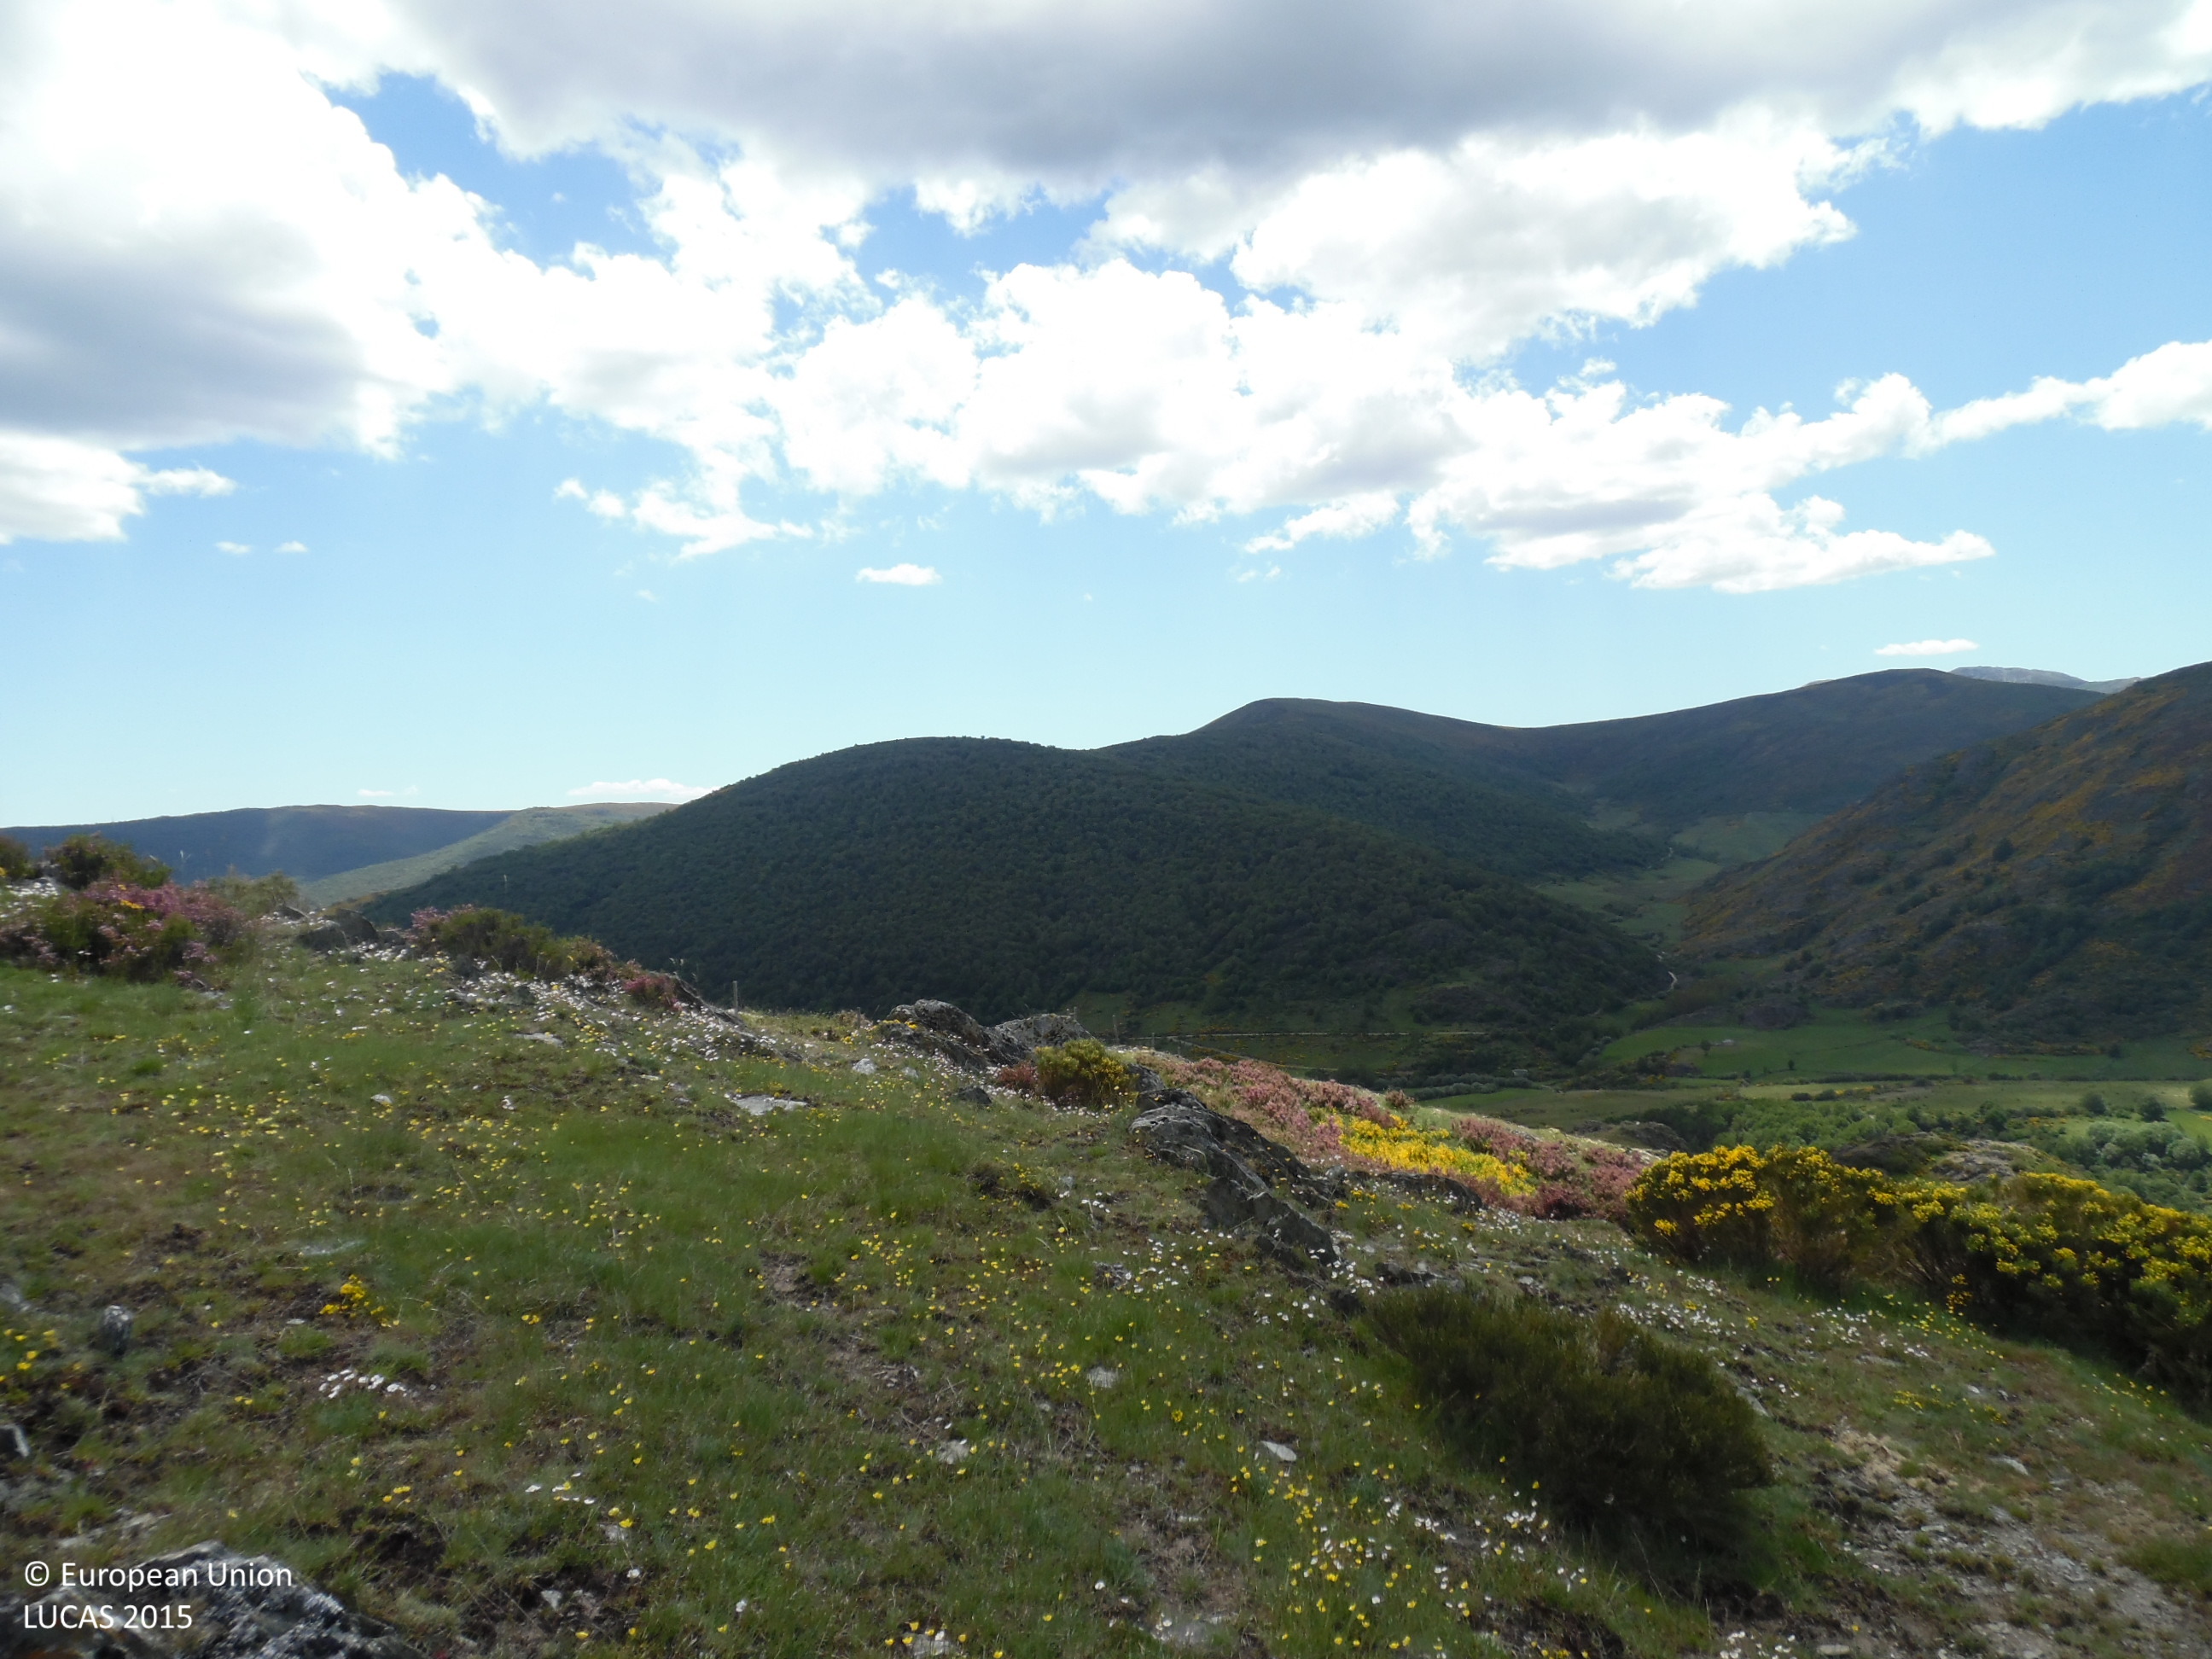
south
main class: Shrubland
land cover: Shrubland without tree cover
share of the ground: 25 - 50 %
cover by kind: herbaceous plants 60 %, shrubs 40 %
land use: Agriculture (excluding fallow land and kitchen gardens)
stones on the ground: 25 - 50 %
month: May
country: ES
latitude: 42.8813
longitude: -6.2147
